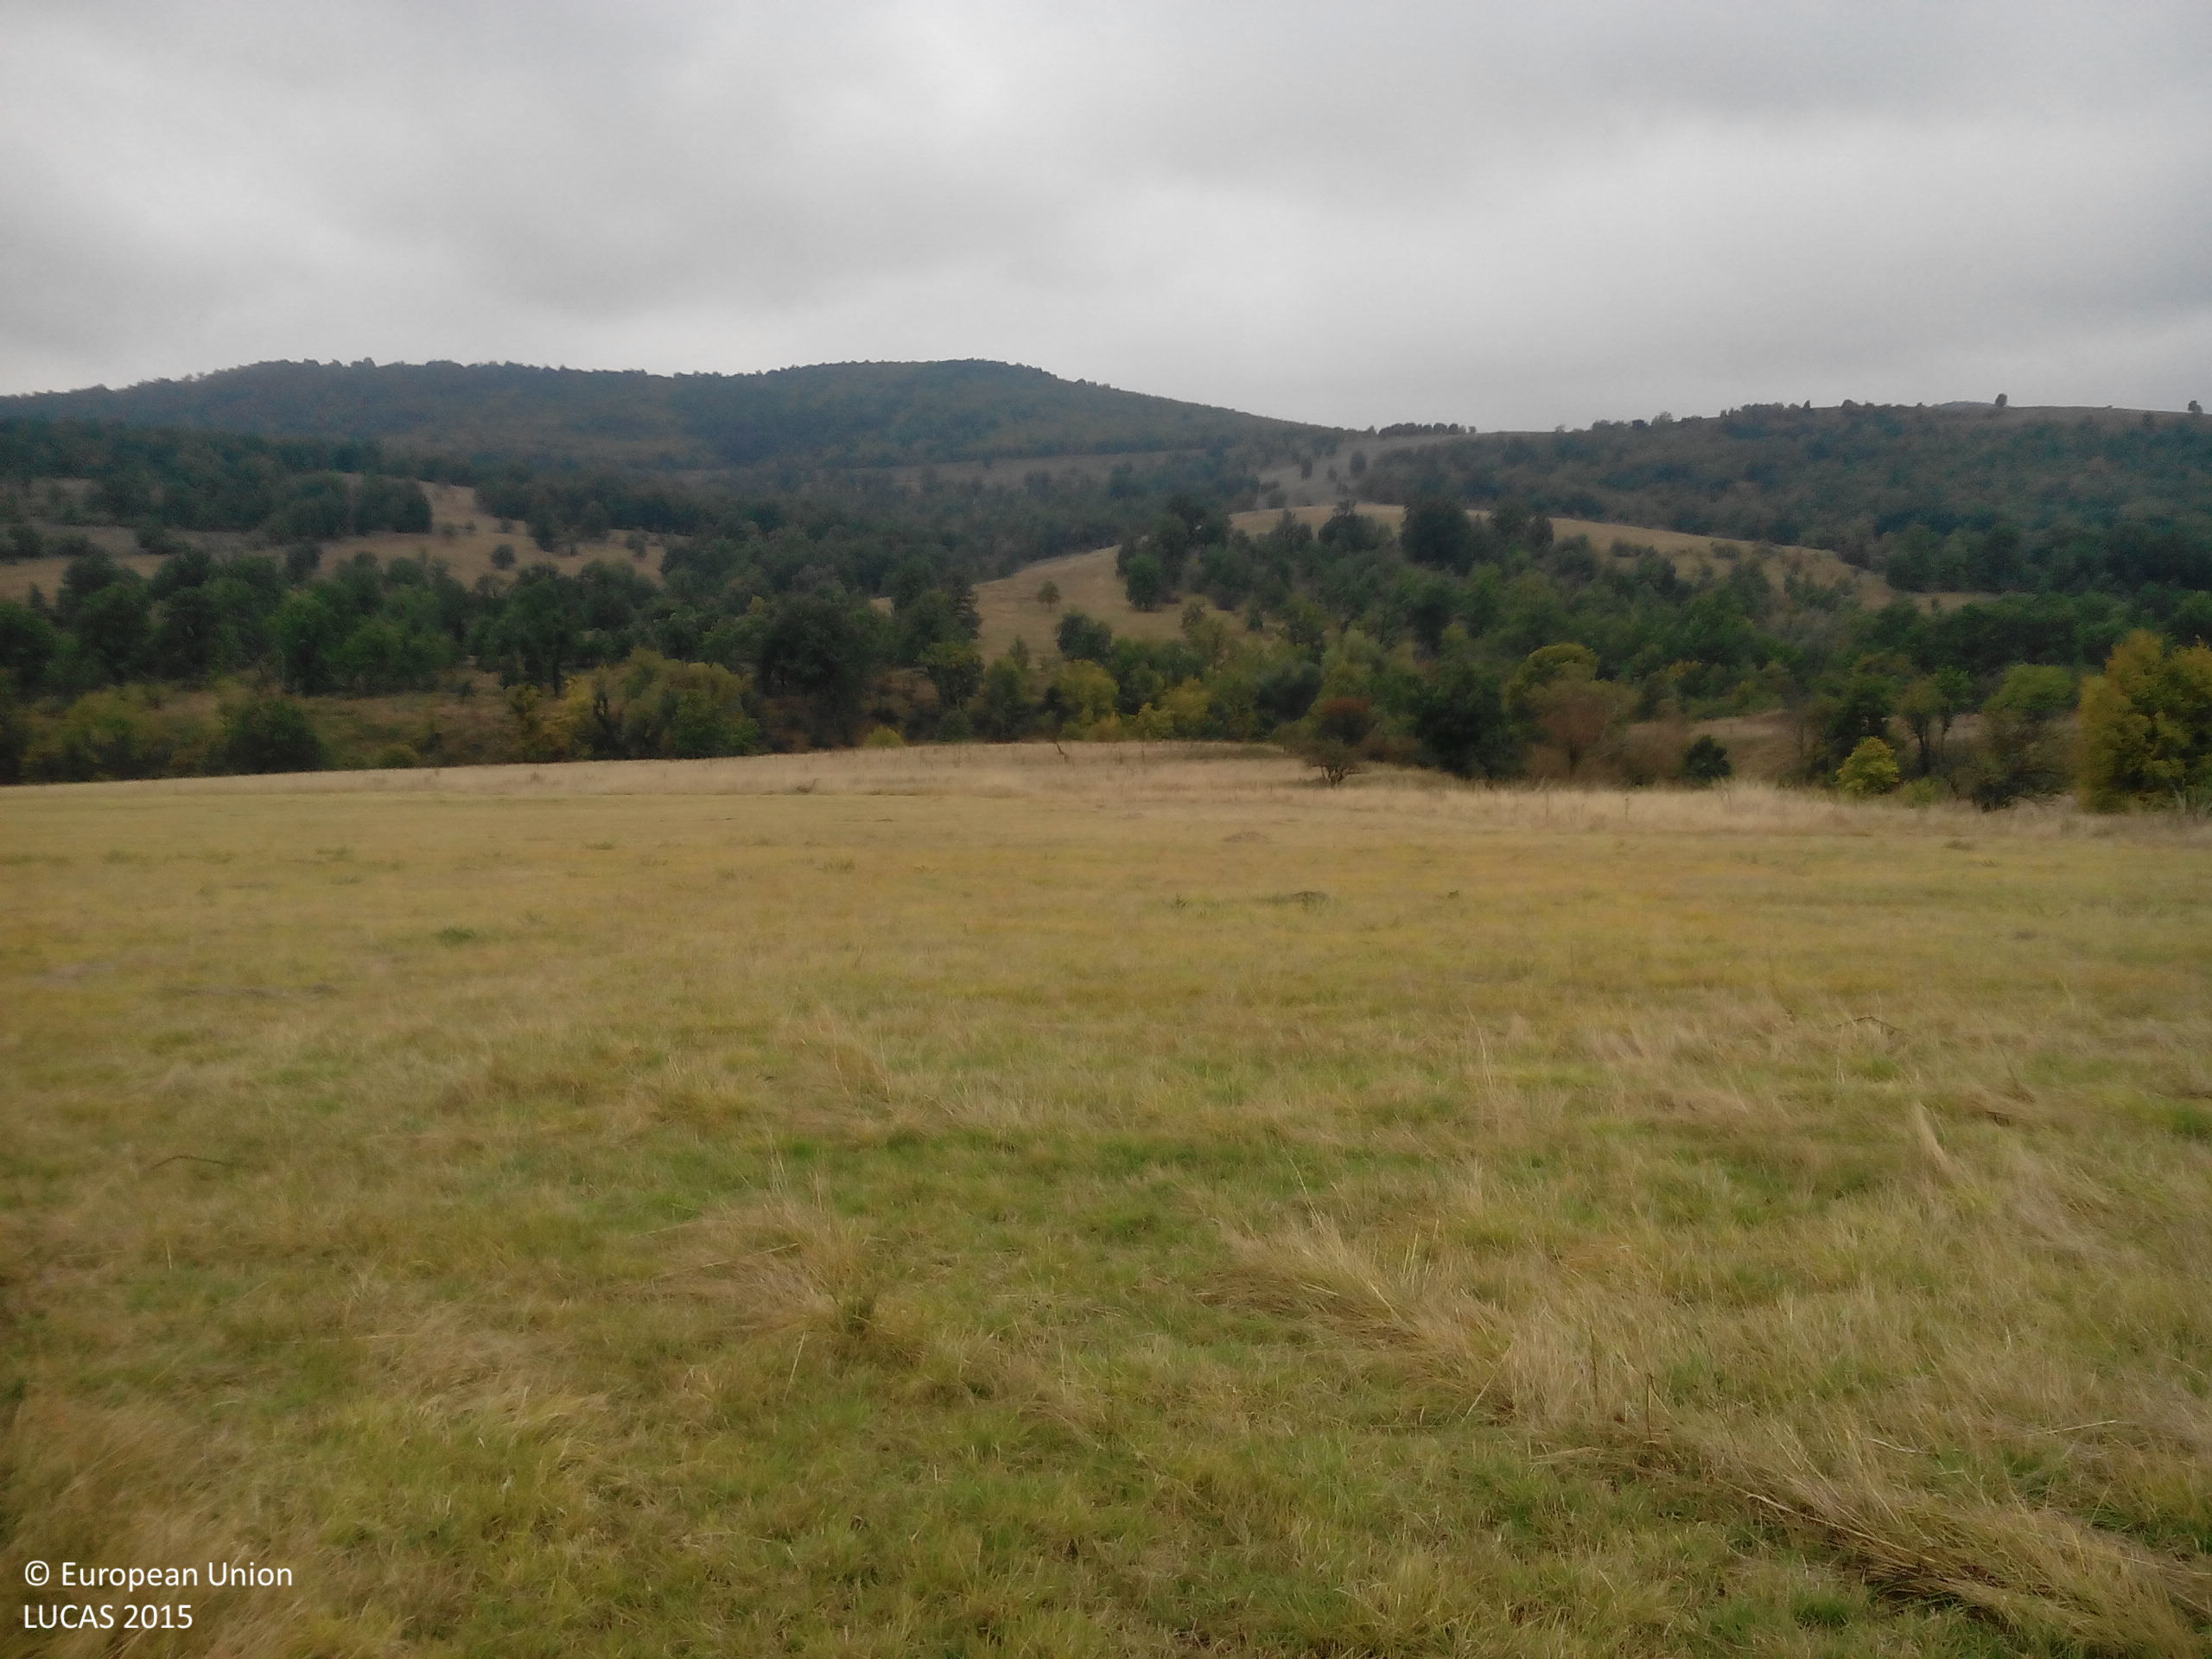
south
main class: Grassland
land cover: Grassland without tree/shrub cover
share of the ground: > 75 %
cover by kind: herbaceous plants 100 %
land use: Agriculture (excluding fallow land and kitchen gardens)
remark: Harvested field
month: October
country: BG
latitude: 43.1294
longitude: 24.0762
